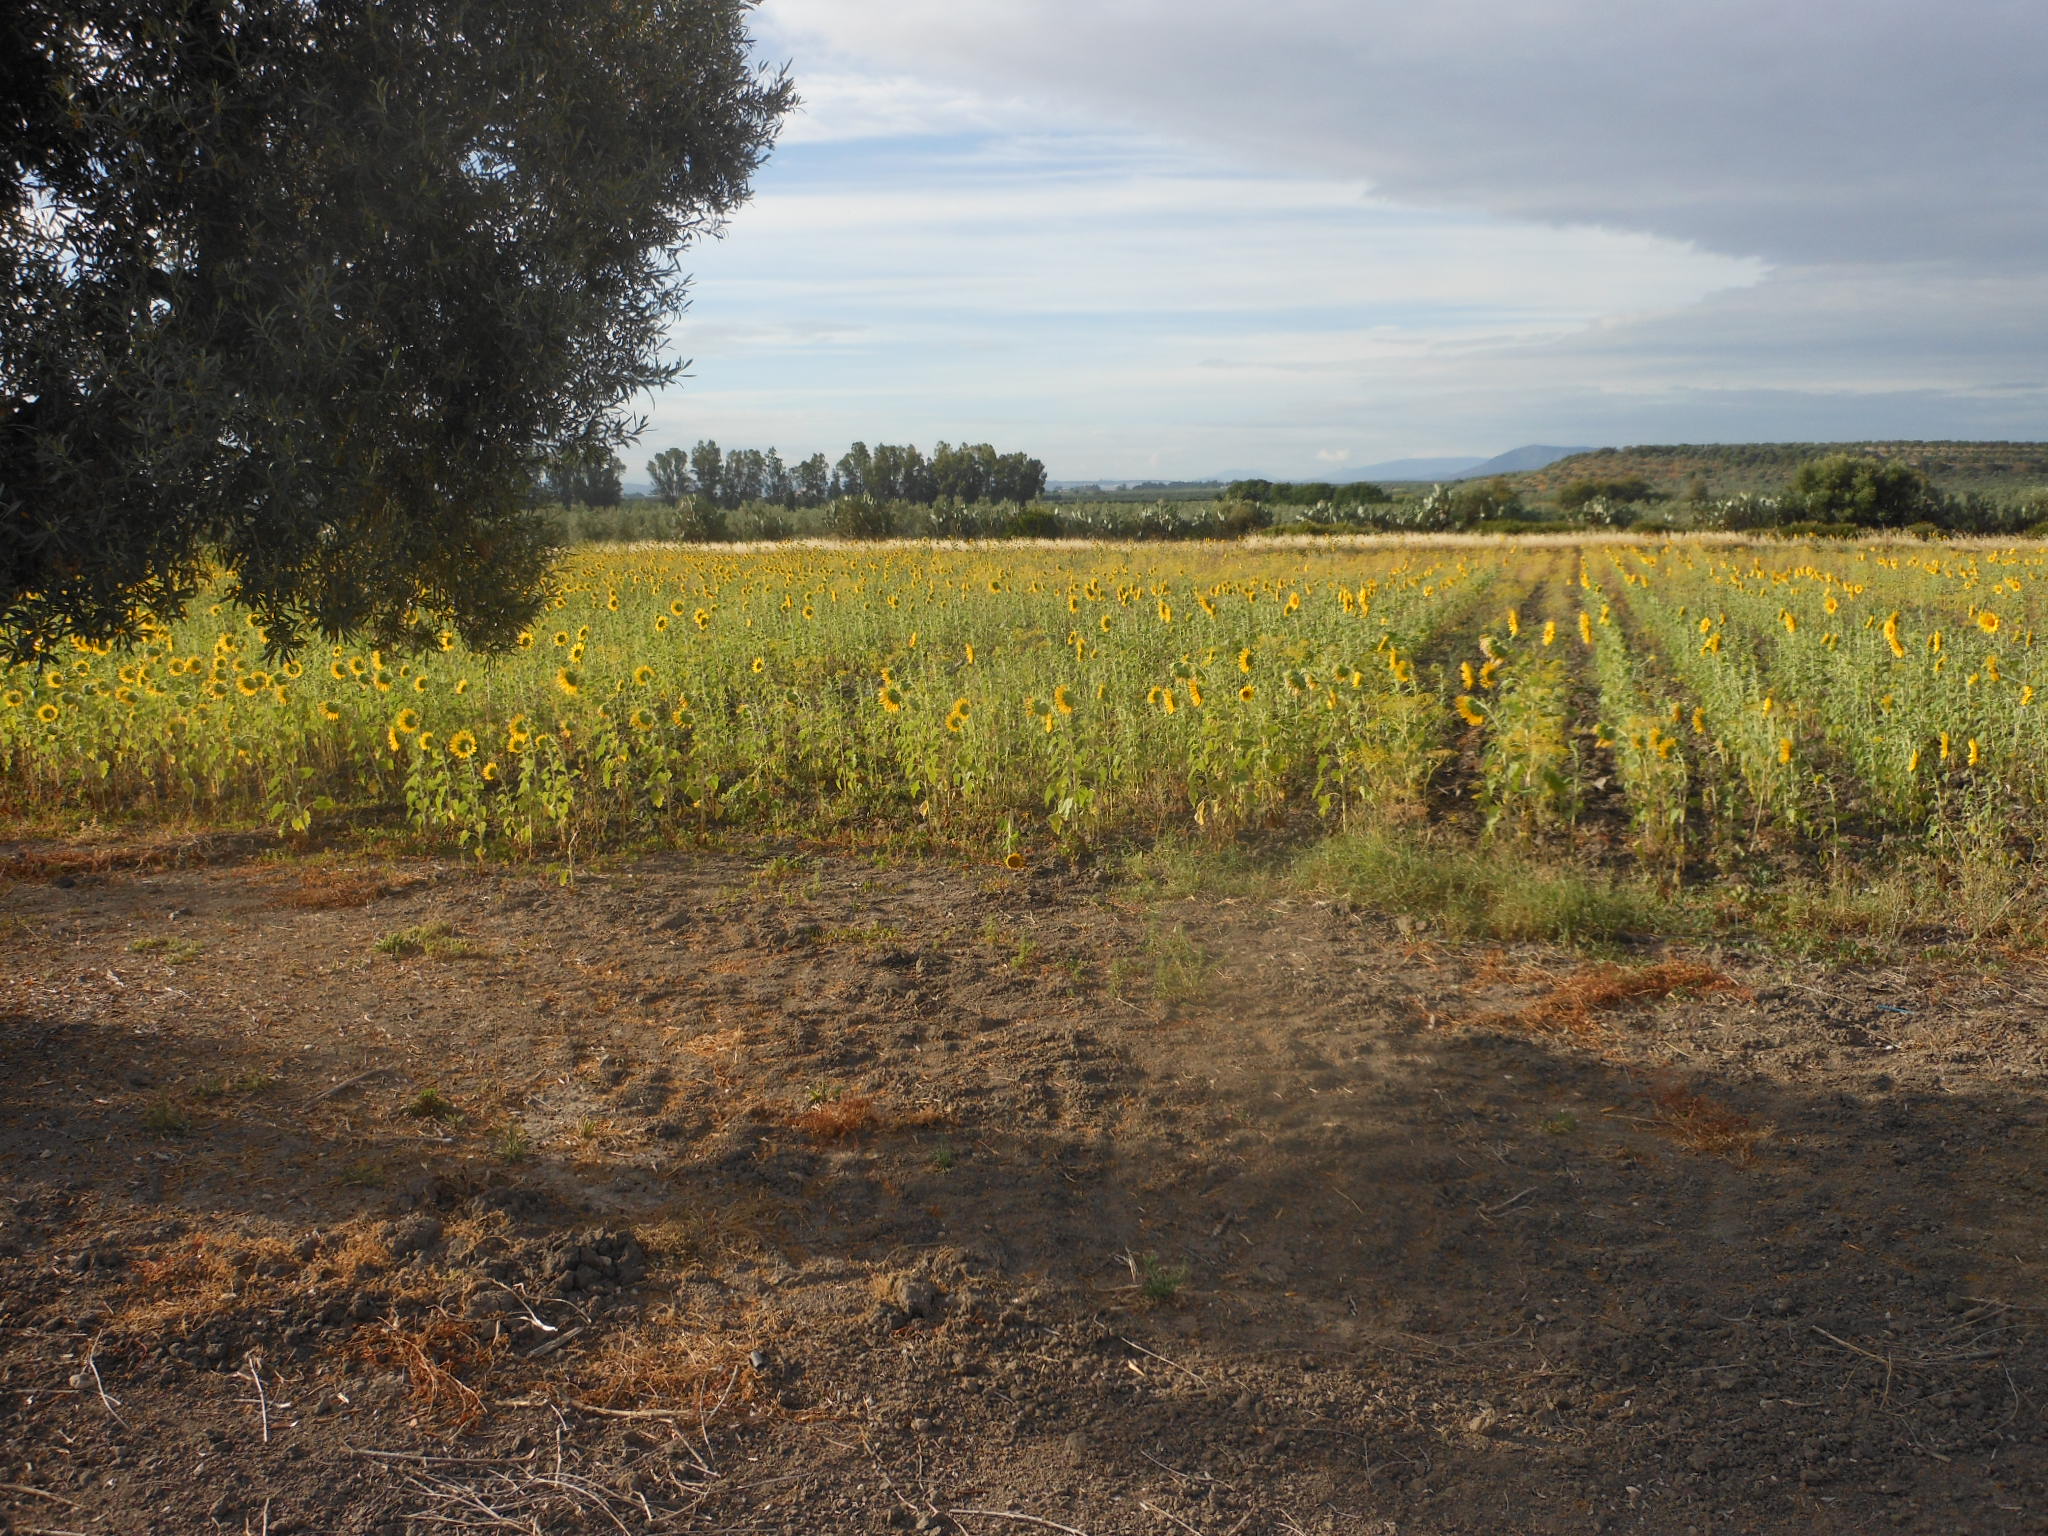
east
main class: Cropland
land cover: Olive groves
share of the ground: 50 - 75 %
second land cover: Other bare soil
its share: > 75 %
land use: Agriculture (excluding fallow land and kitchen gardens)
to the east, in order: Olive groves; Other bare soil; Sunflower; Grass margins; Tracks; Grass margins; Olive groves
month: June
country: ES
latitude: 37.2362
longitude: -5.5352
